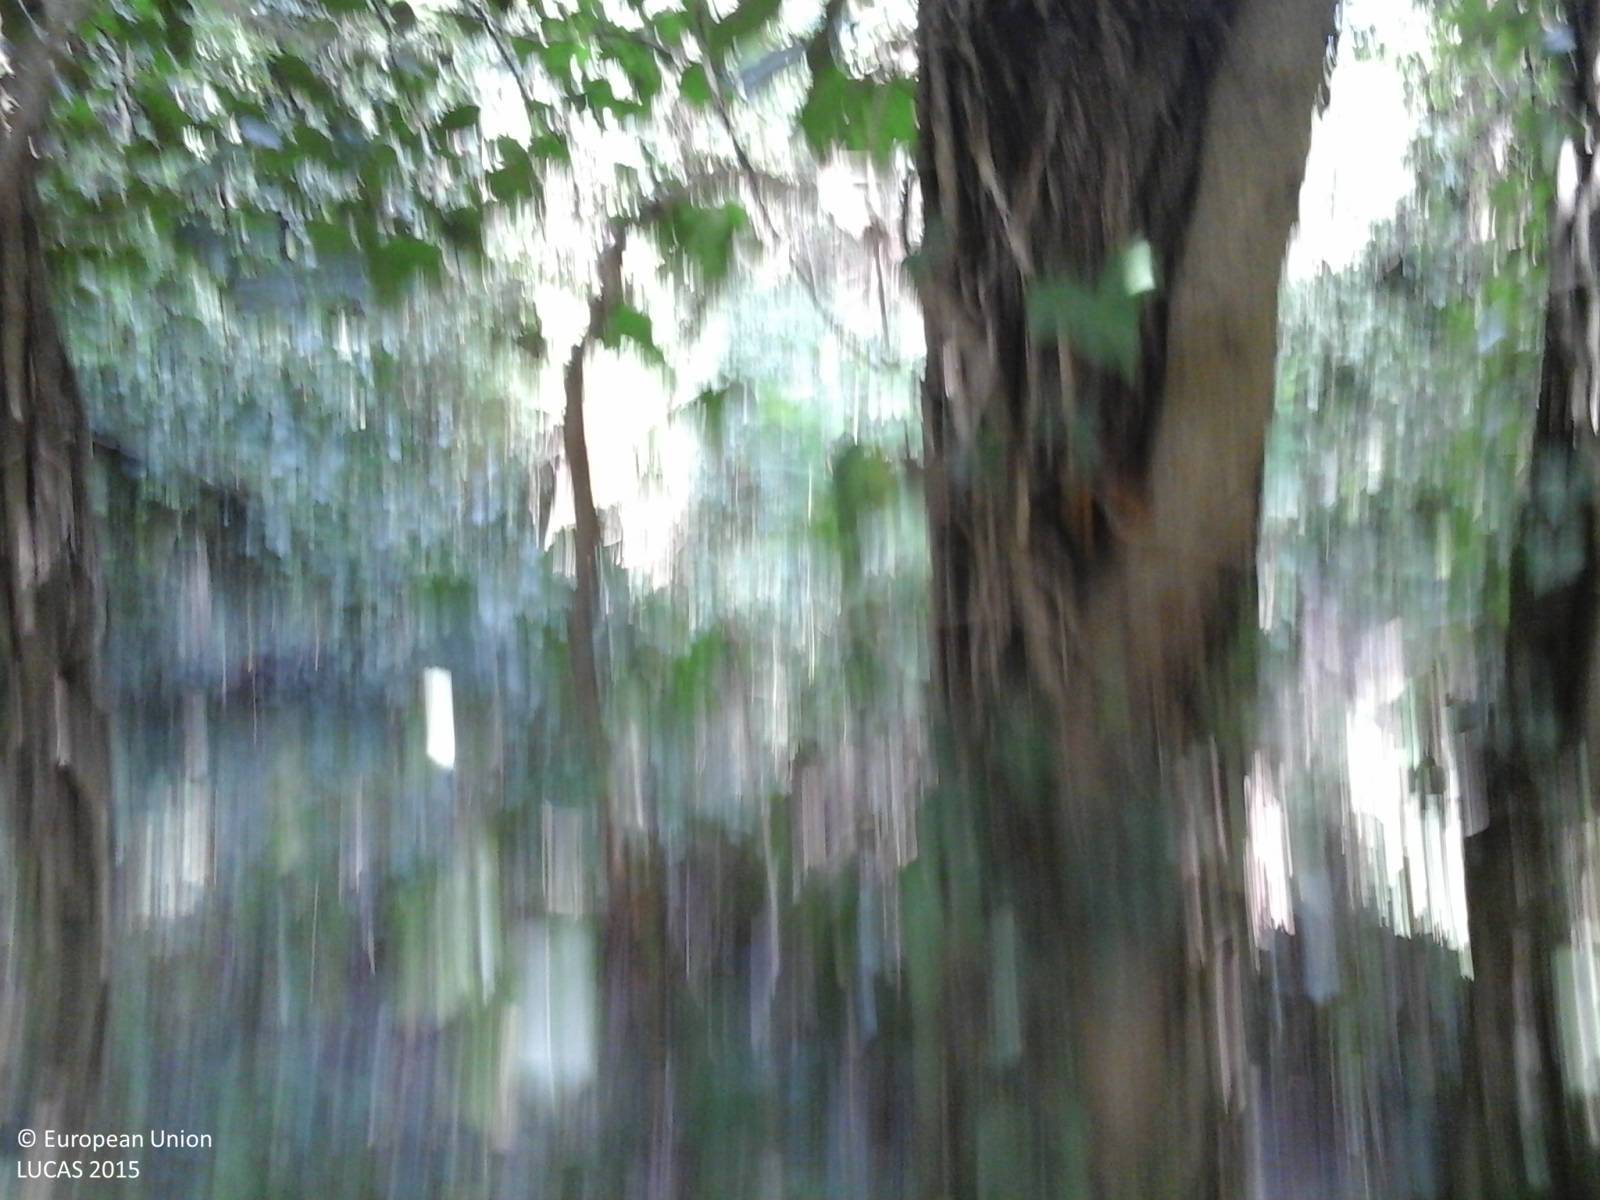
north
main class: Woodland
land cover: Broadleaved woodland
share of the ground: > 75 %
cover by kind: broadleaved forest trees 80 %, shrubs 20 %
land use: Forestry
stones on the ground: < 10 %
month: September
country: IT
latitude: 42.9757
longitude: 12.0905
